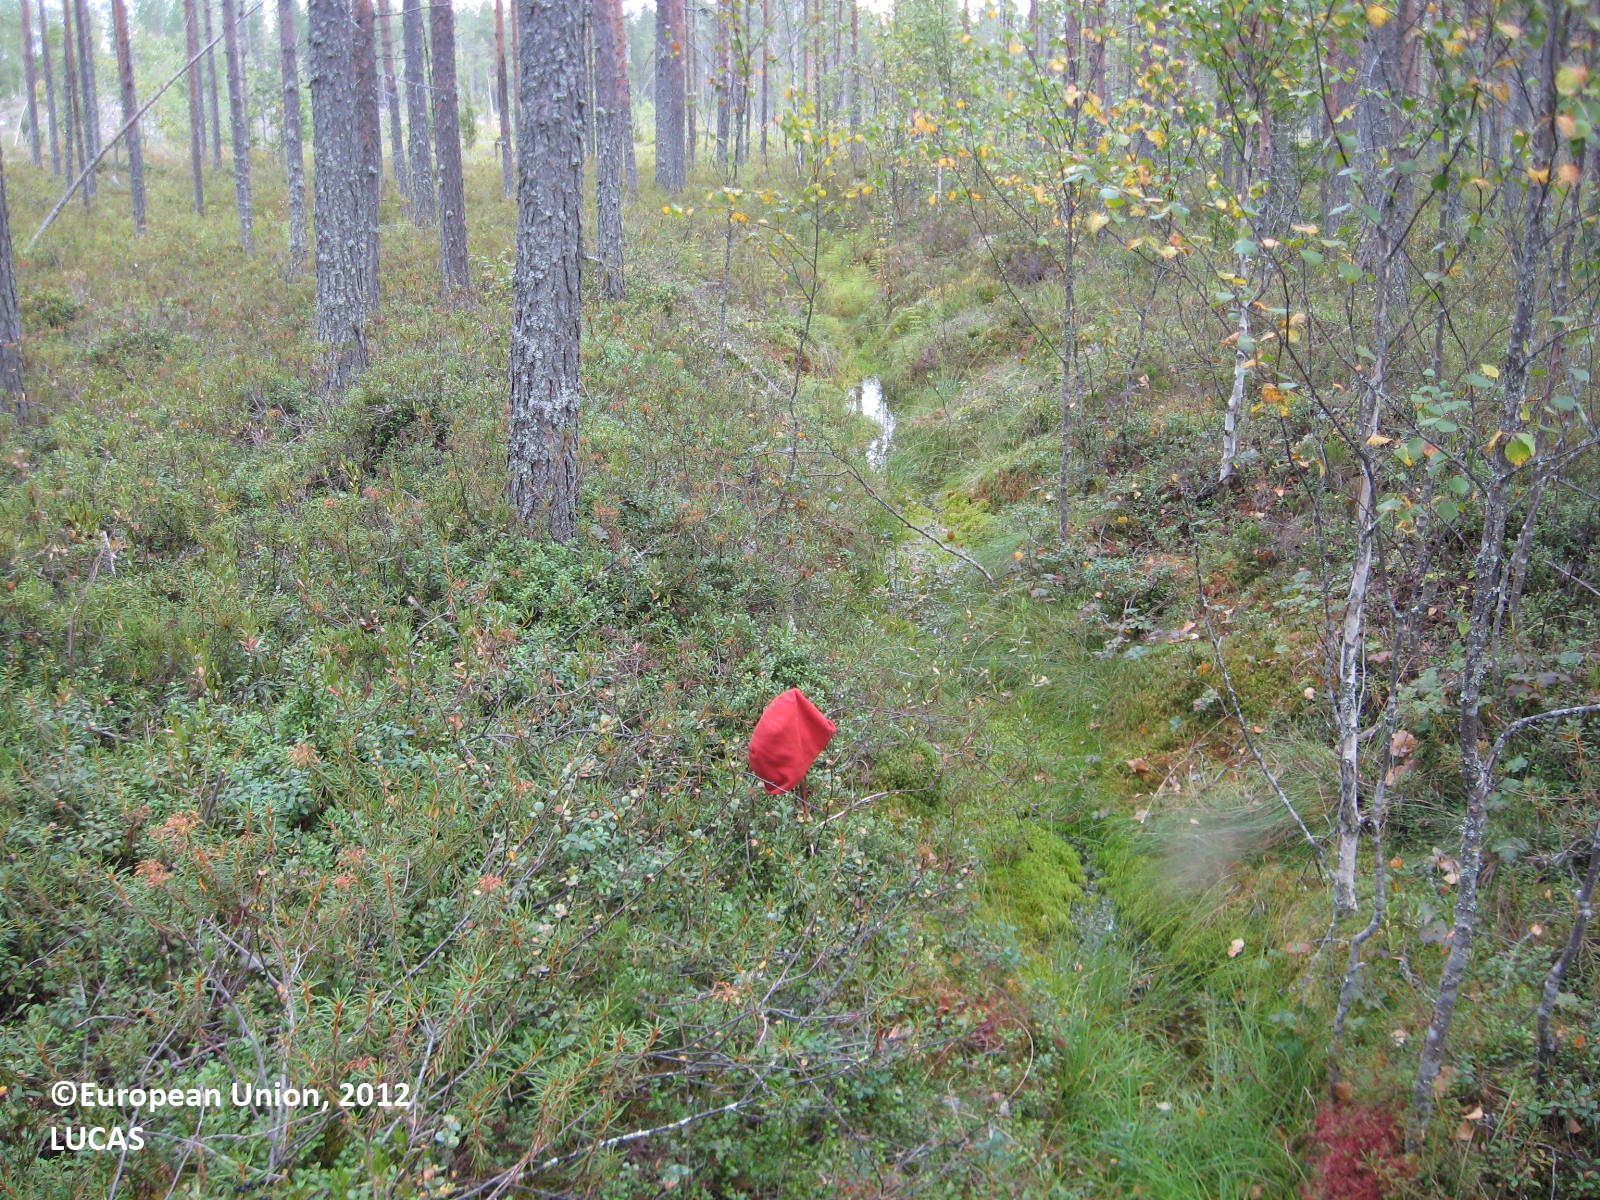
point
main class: Woodland
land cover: Pine dominated coniferous woodland
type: boreal forest
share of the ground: > 75 %
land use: Forestry
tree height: > 5 m
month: August
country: FI
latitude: 63.5502
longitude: 30.1557
